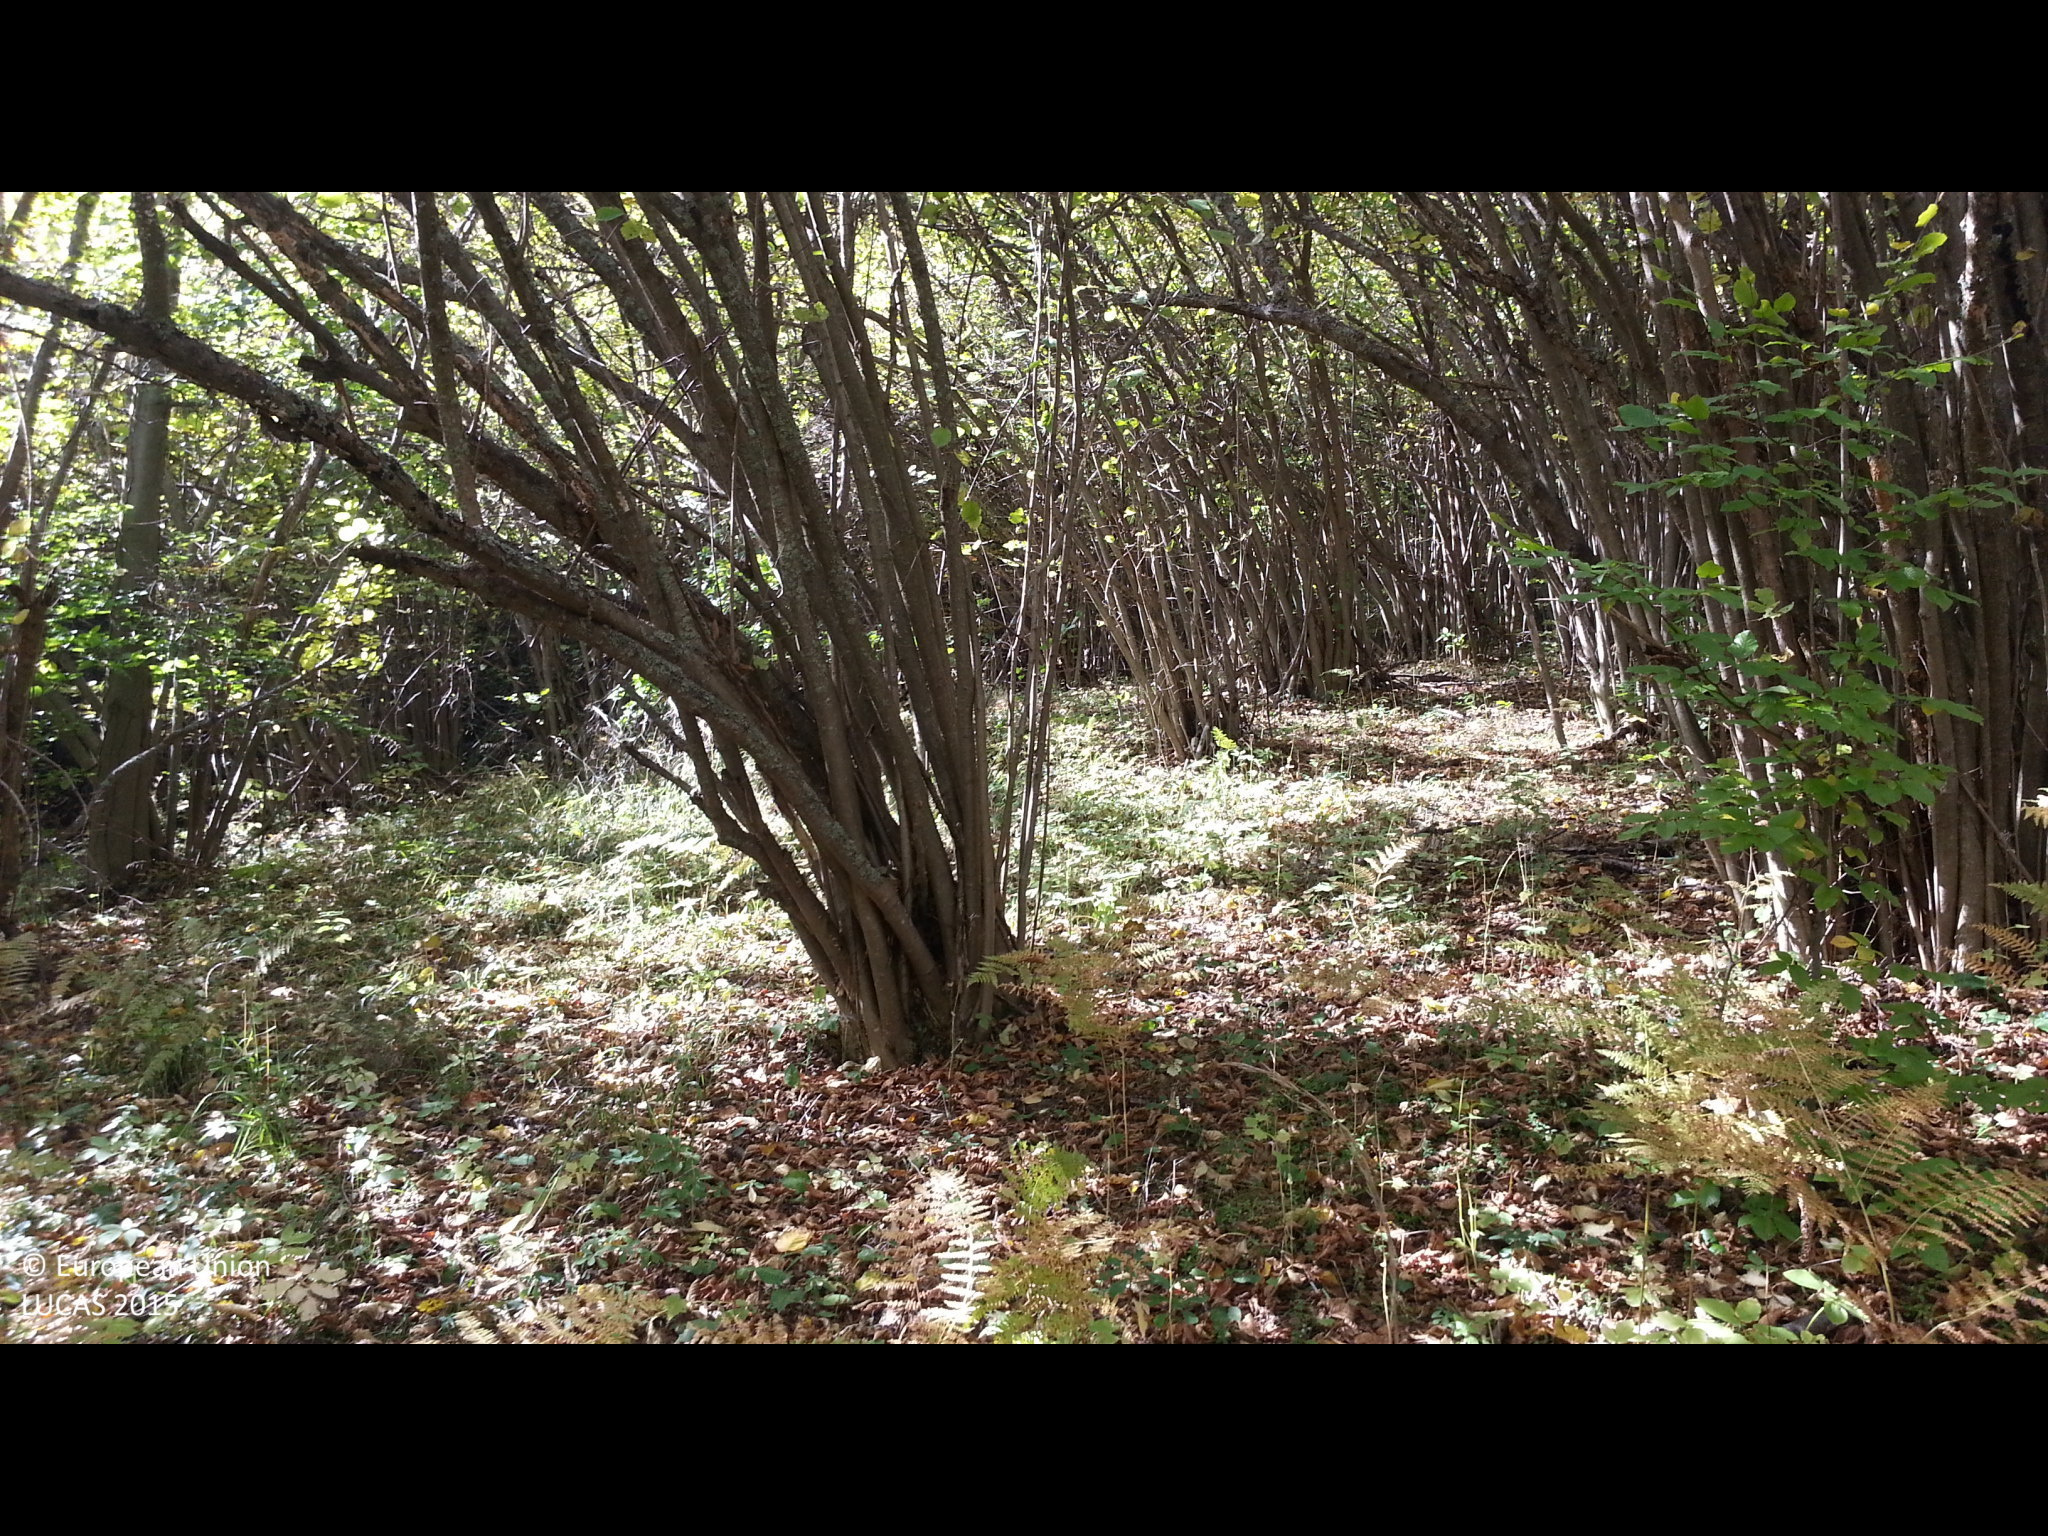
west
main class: Woodland
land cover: Broadleaved woodland
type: mesophytic deciduous forest
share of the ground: 50 - 75 %
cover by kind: broadleaved forest trees 65 %, herbaceous plants 35 %
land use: Forestry
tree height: > 5 m
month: October
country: BG
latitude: 42.4720
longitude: 23.4004
